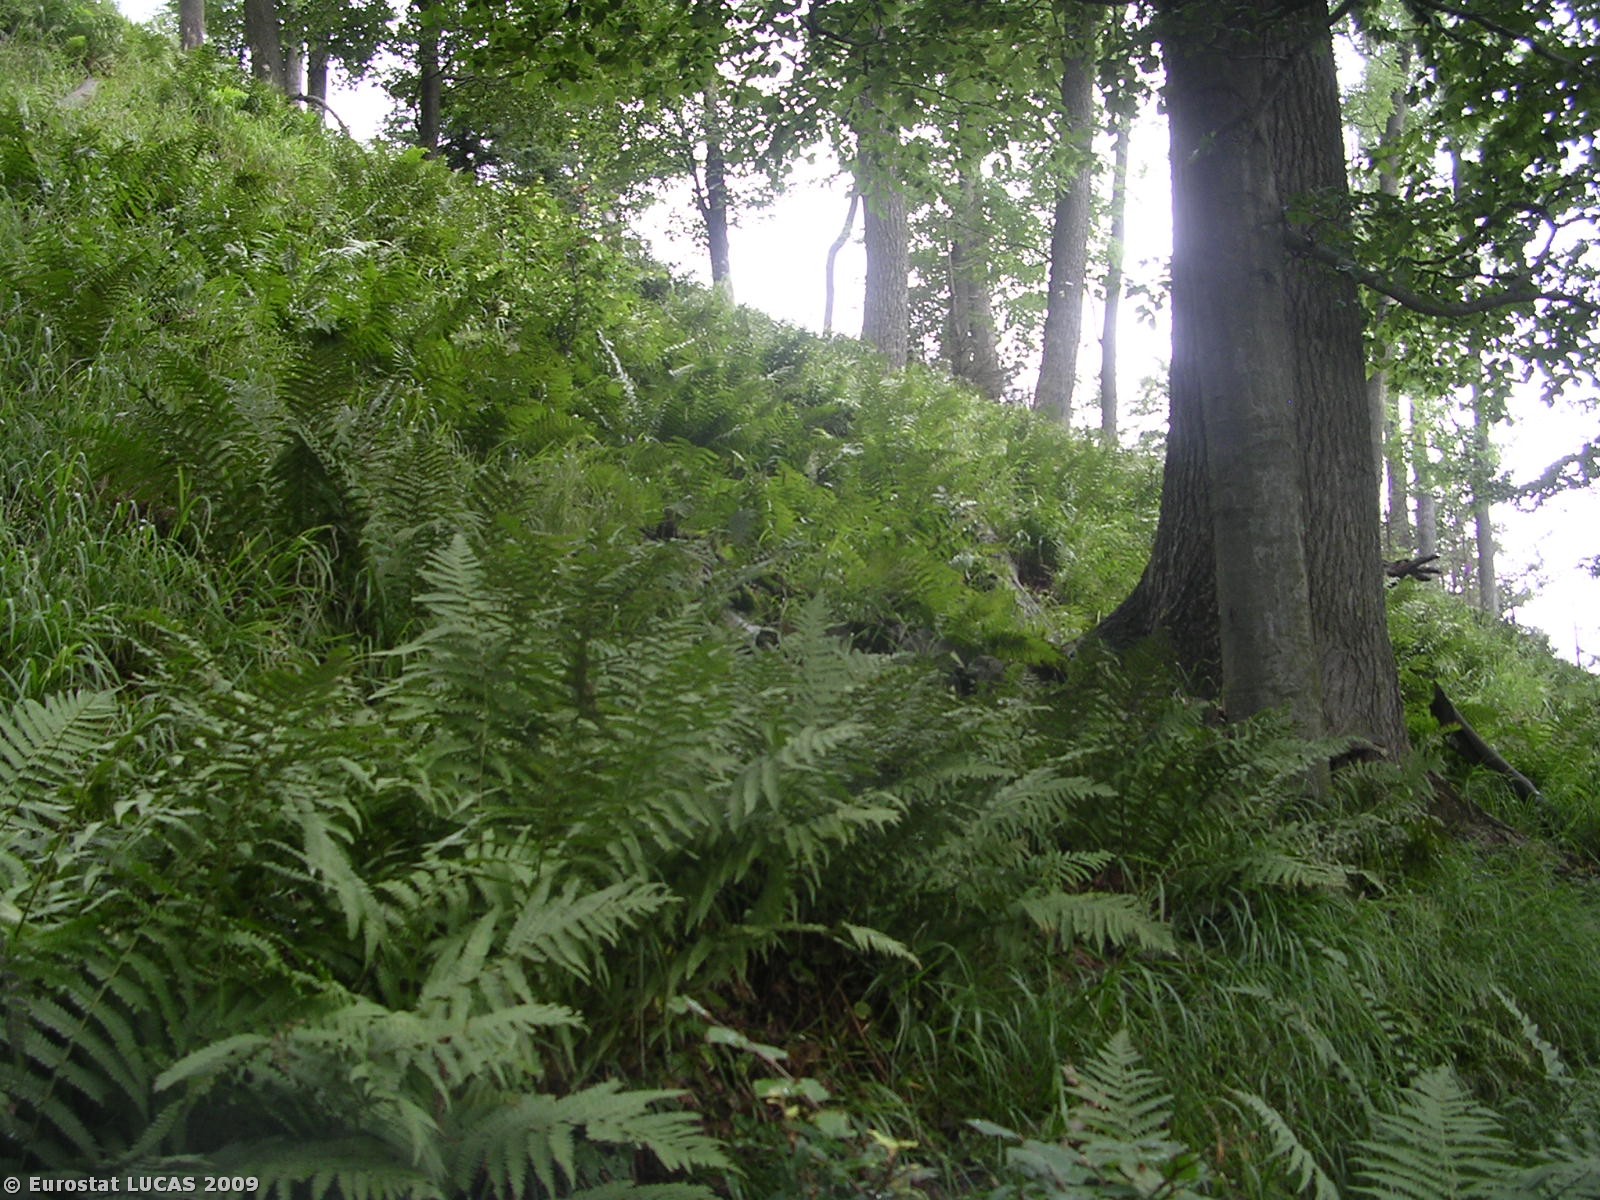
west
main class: Woodland
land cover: Broadleaved woodland
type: mountainous beech forest
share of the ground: > 75 %
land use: Forestry
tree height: > 5 m
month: July
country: CZ
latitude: 50.7956
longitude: 14.5561
